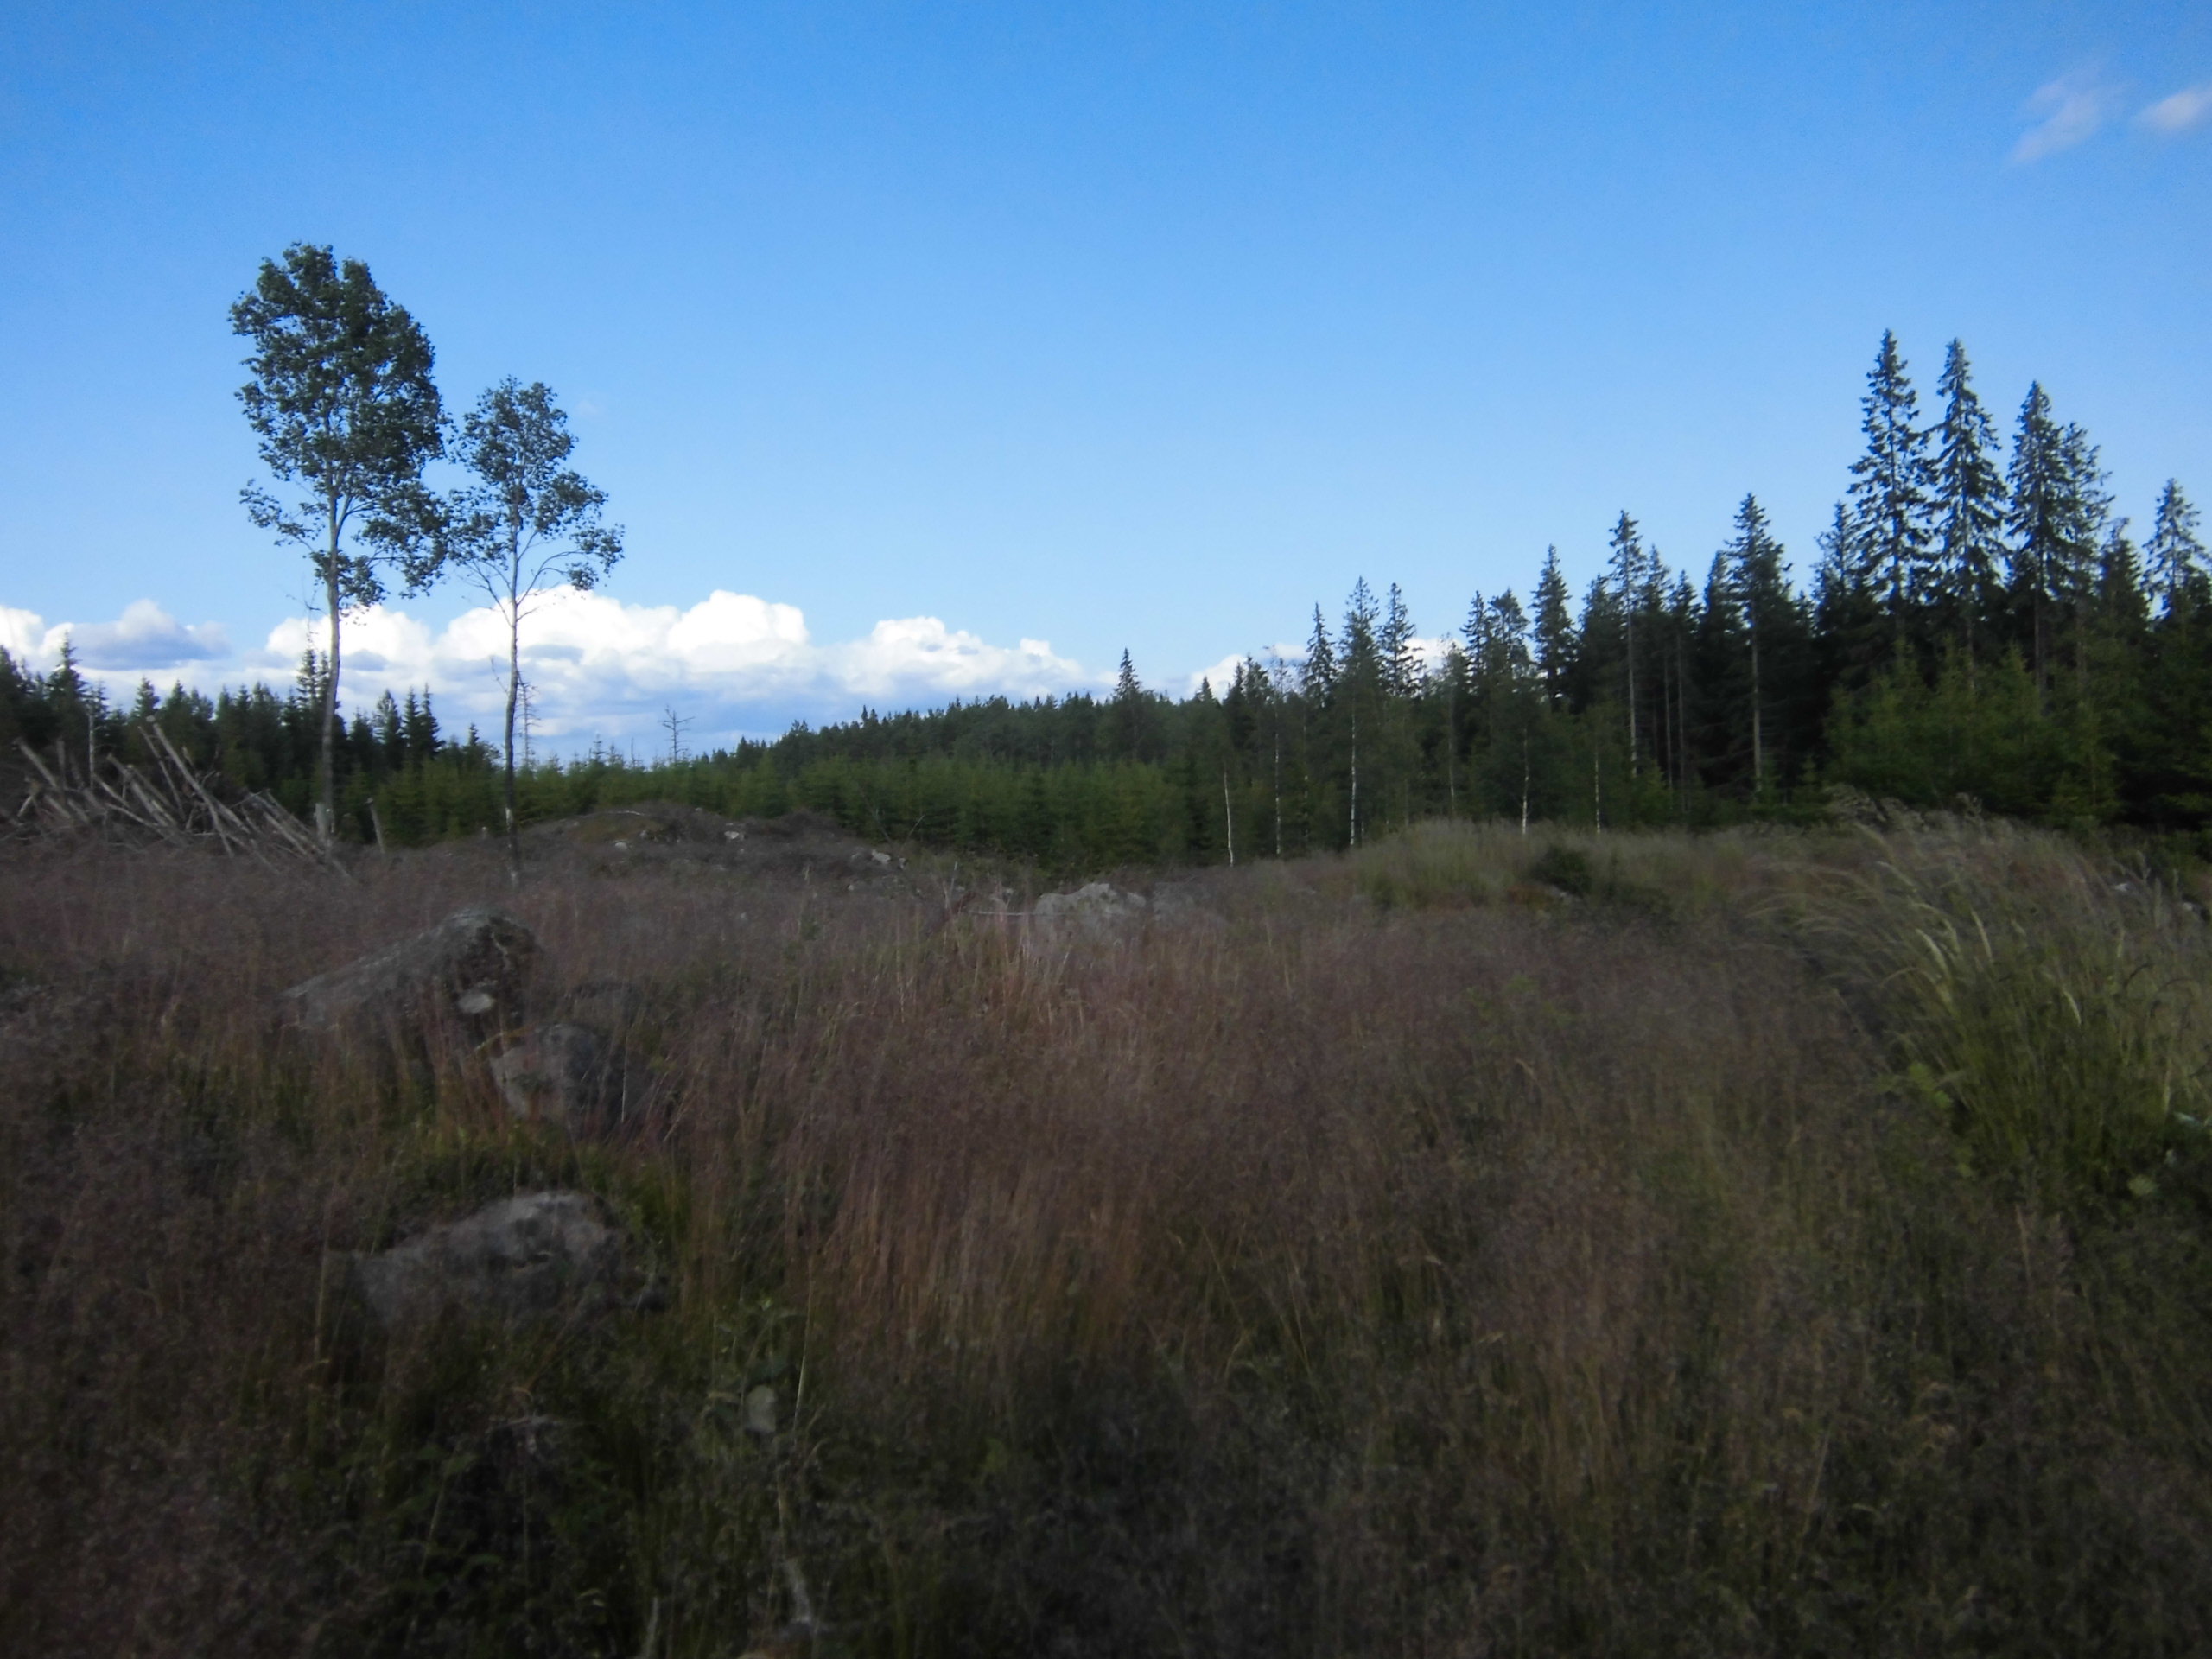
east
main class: Grassland
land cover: Grassland with sparse tree/shrub cover
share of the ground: > 75 %
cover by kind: herbaceous plants 70 %, lichens and mosses 10 %, unconsolidated bare surface 10 %, broadleaved forest trees 5 %, shrubs 5 %
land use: Forestry
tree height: < 5 m
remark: Clear cut
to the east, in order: Grassland with sparse tree/shrub cover; Broadleaved woodland; Grassland with sparse tree/shrub cover; Spruce dominated coniferous woodland; Spruce dominated mixed woodland; Pine dominated mixed woodland
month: July
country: SE
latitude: 57.2159
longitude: 15.2462
